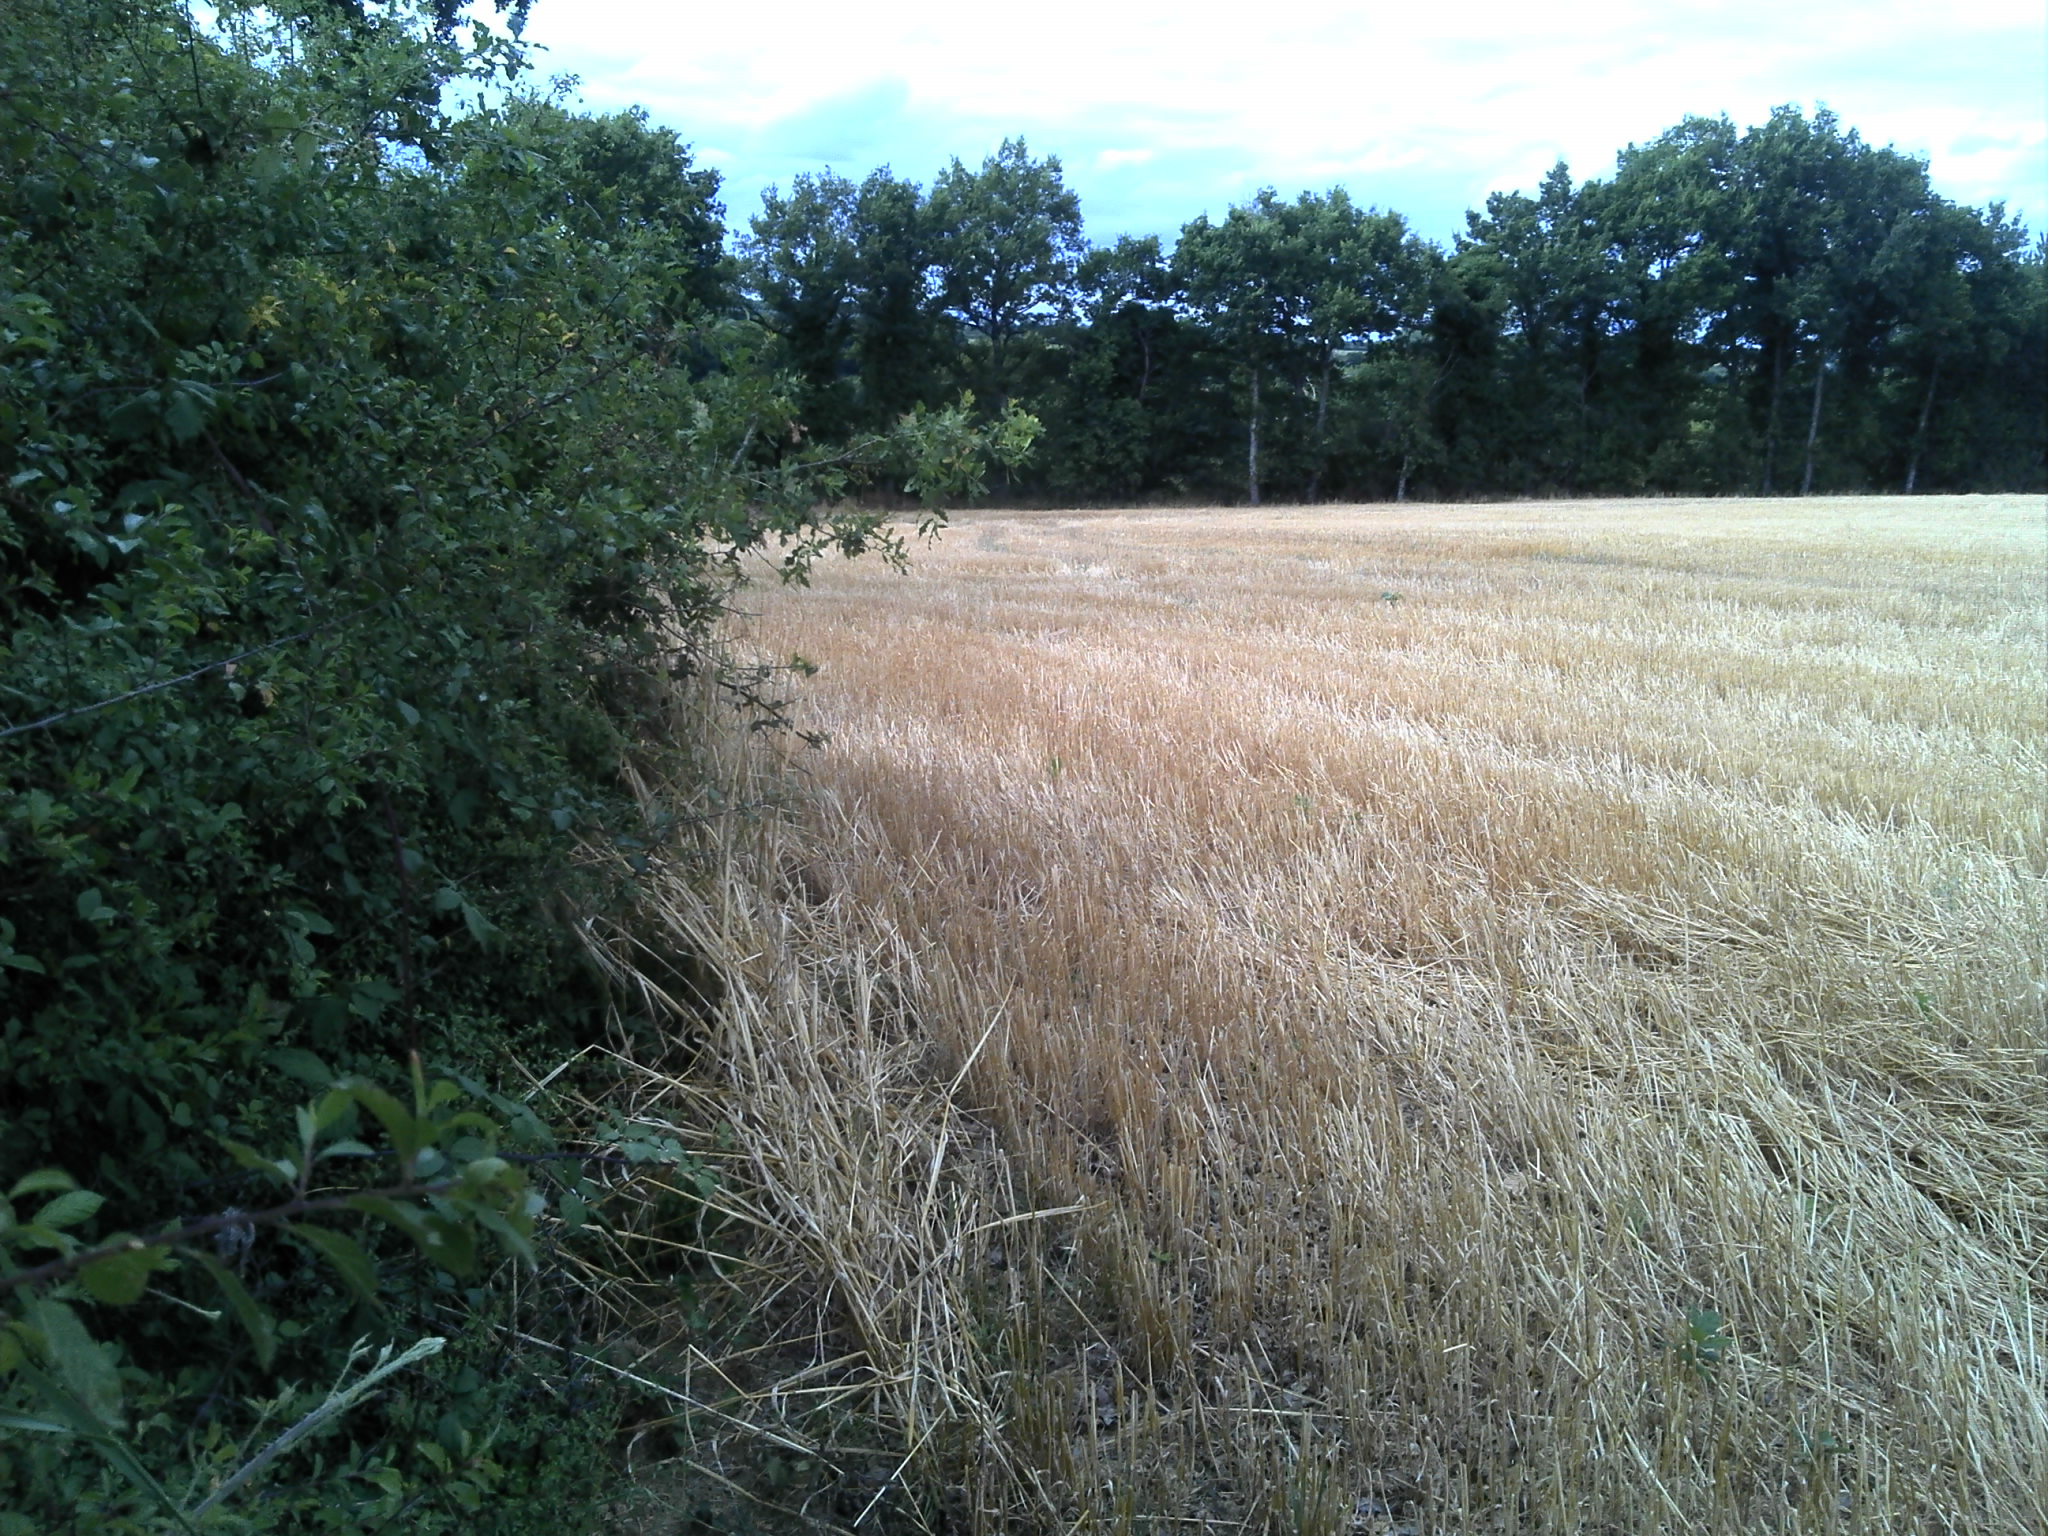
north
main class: Cropland
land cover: Barley
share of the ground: > 75 %
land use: Agriculture (excluding fallow land and kitchen gardens)
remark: Harvested field
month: July
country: FR
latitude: 46.4681
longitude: 1.5384
